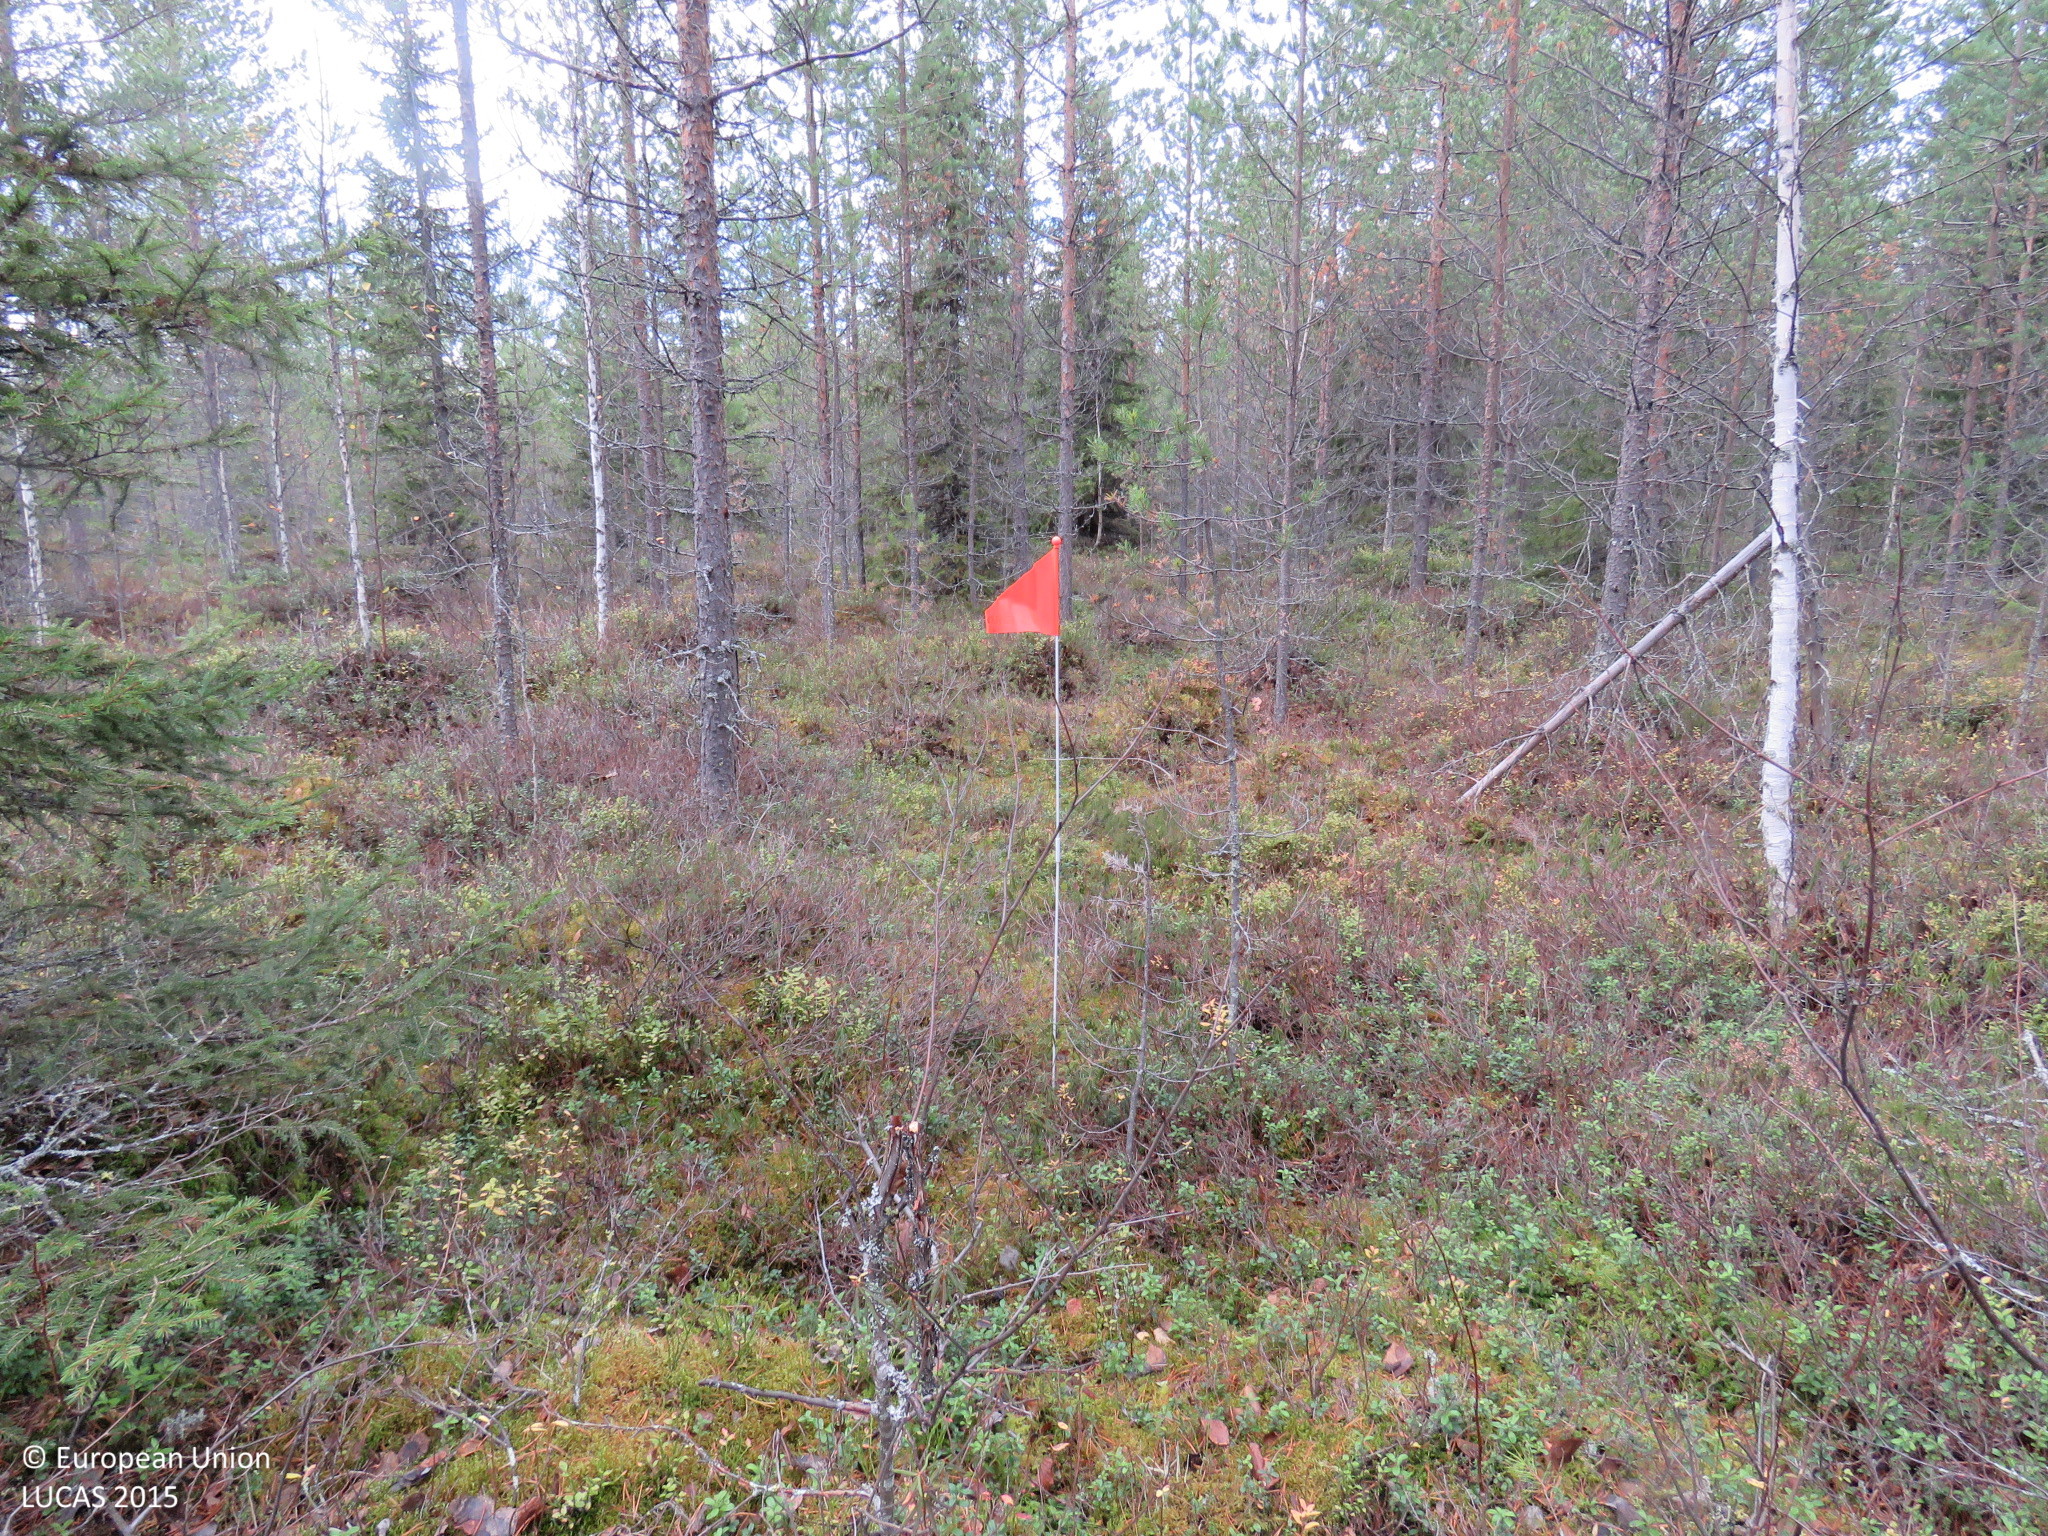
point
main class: Woodland
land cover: Pine dominated coniferous woodland
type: boreal forest
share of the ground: > 75 %
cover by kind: coniferous forest trees 60 %, shrubs 20 %, broadleaved forest trees 15 %, lichens and mosses 5 %
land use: Forestry
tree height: > 5 m
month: October
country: FI
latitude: 64.5652
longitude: 27.0101
